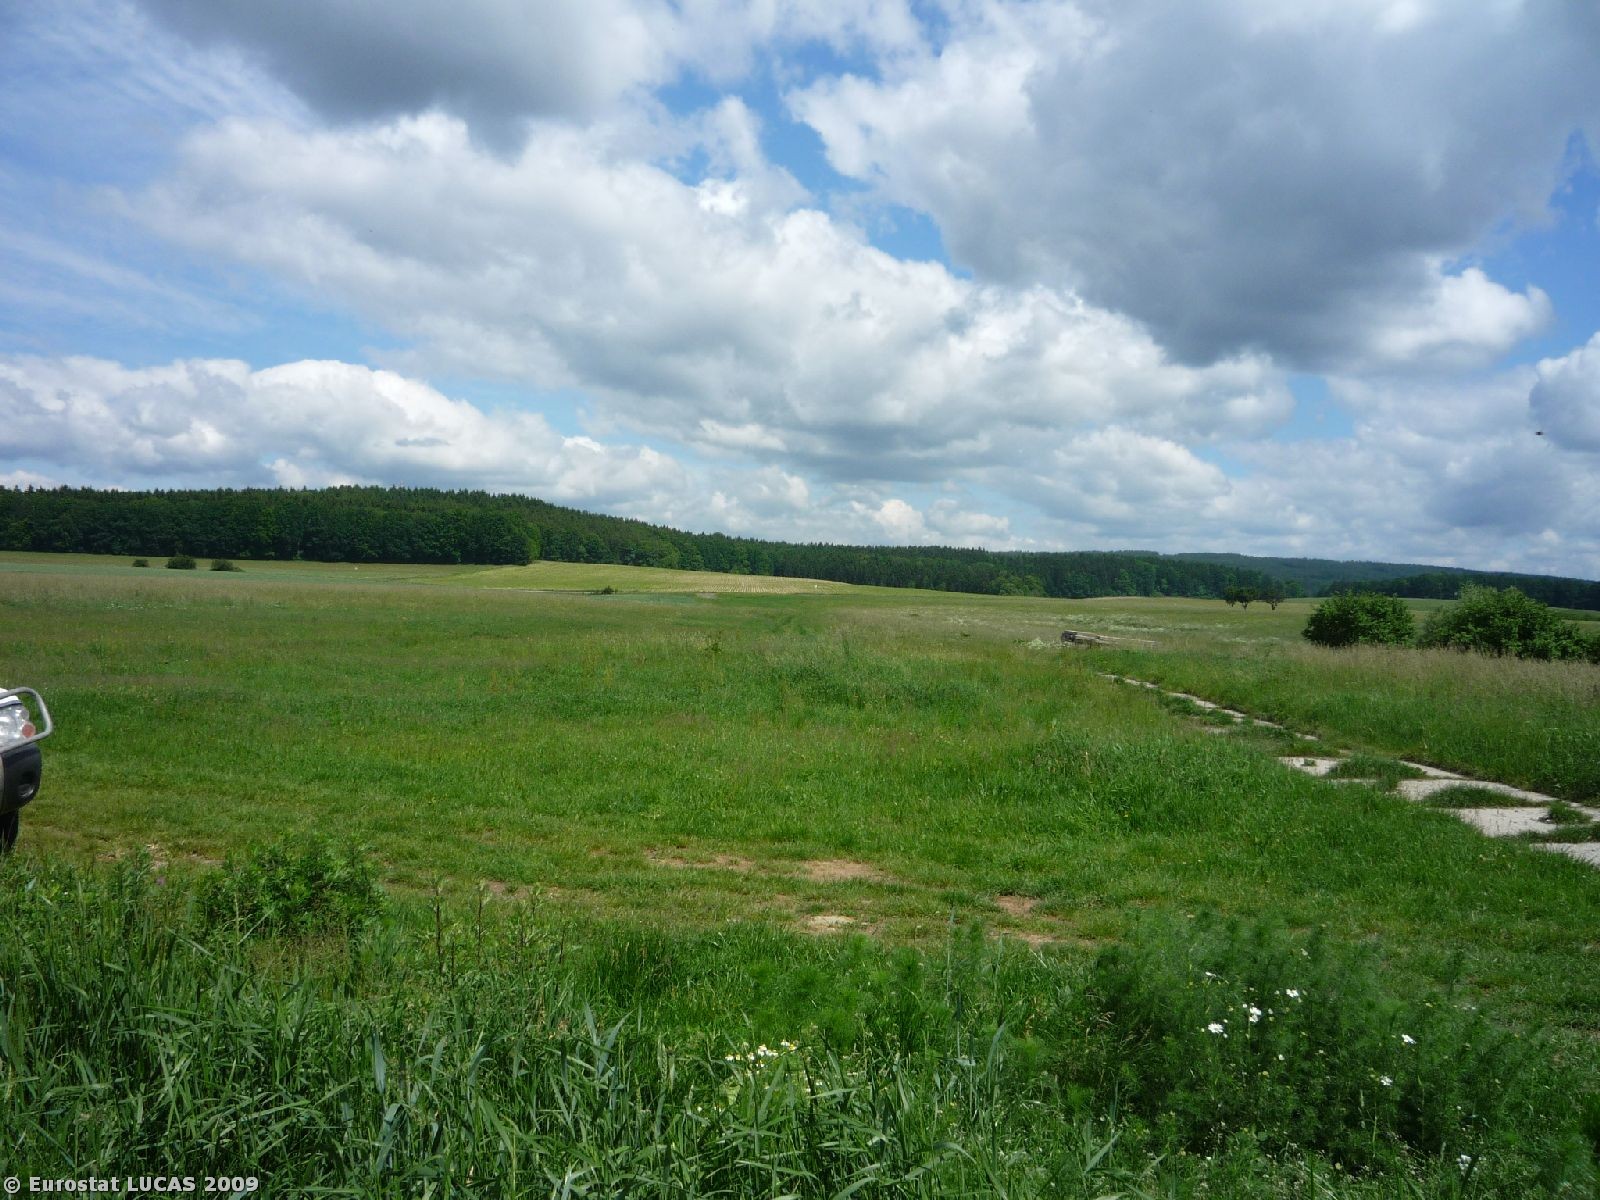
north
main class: Cropland
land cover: Barley
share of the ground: > 75 %
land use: Agriculture (excluding fallow land and kitchen gardens)
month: June
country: CZ
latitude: 50.4283
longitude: 15.5365
